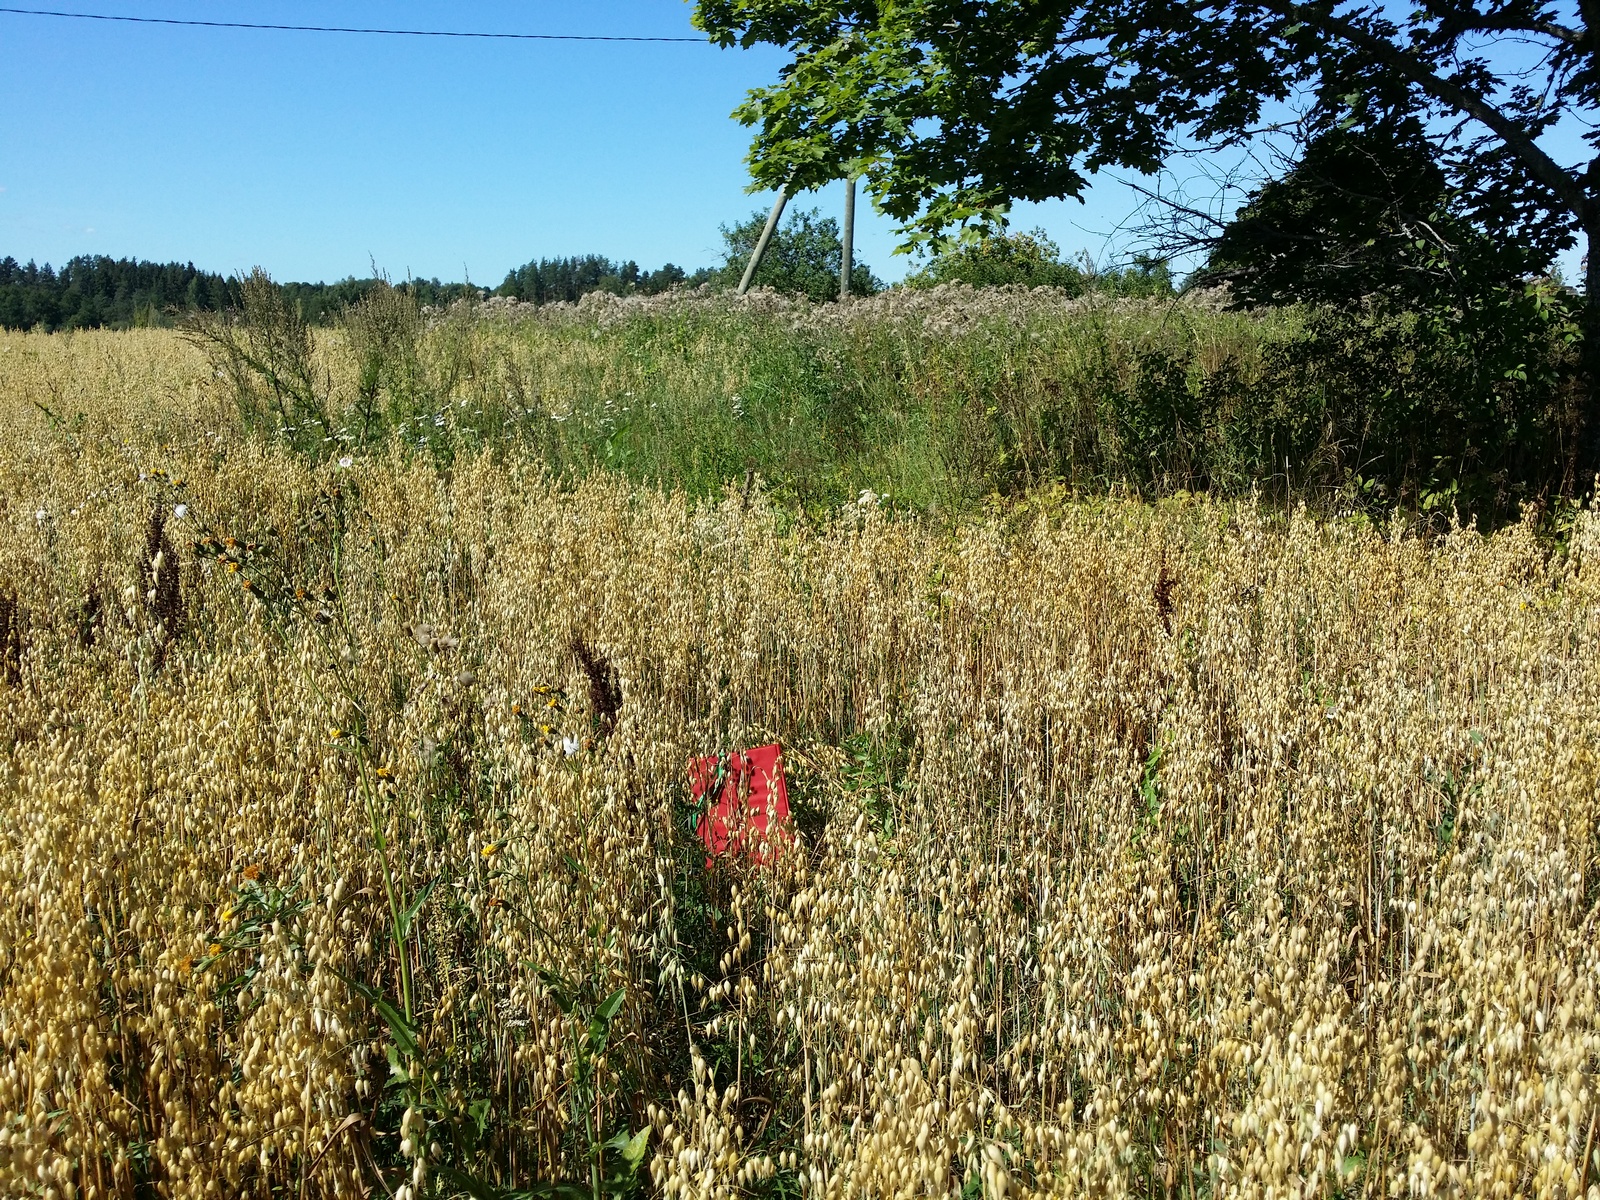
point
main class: Cropland
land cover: Oats
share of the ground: > 75 %
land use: Agriculture (excluding fallow land and kitchen gardens)
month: August
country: LV
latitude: 57.0386
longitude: 27.6331
